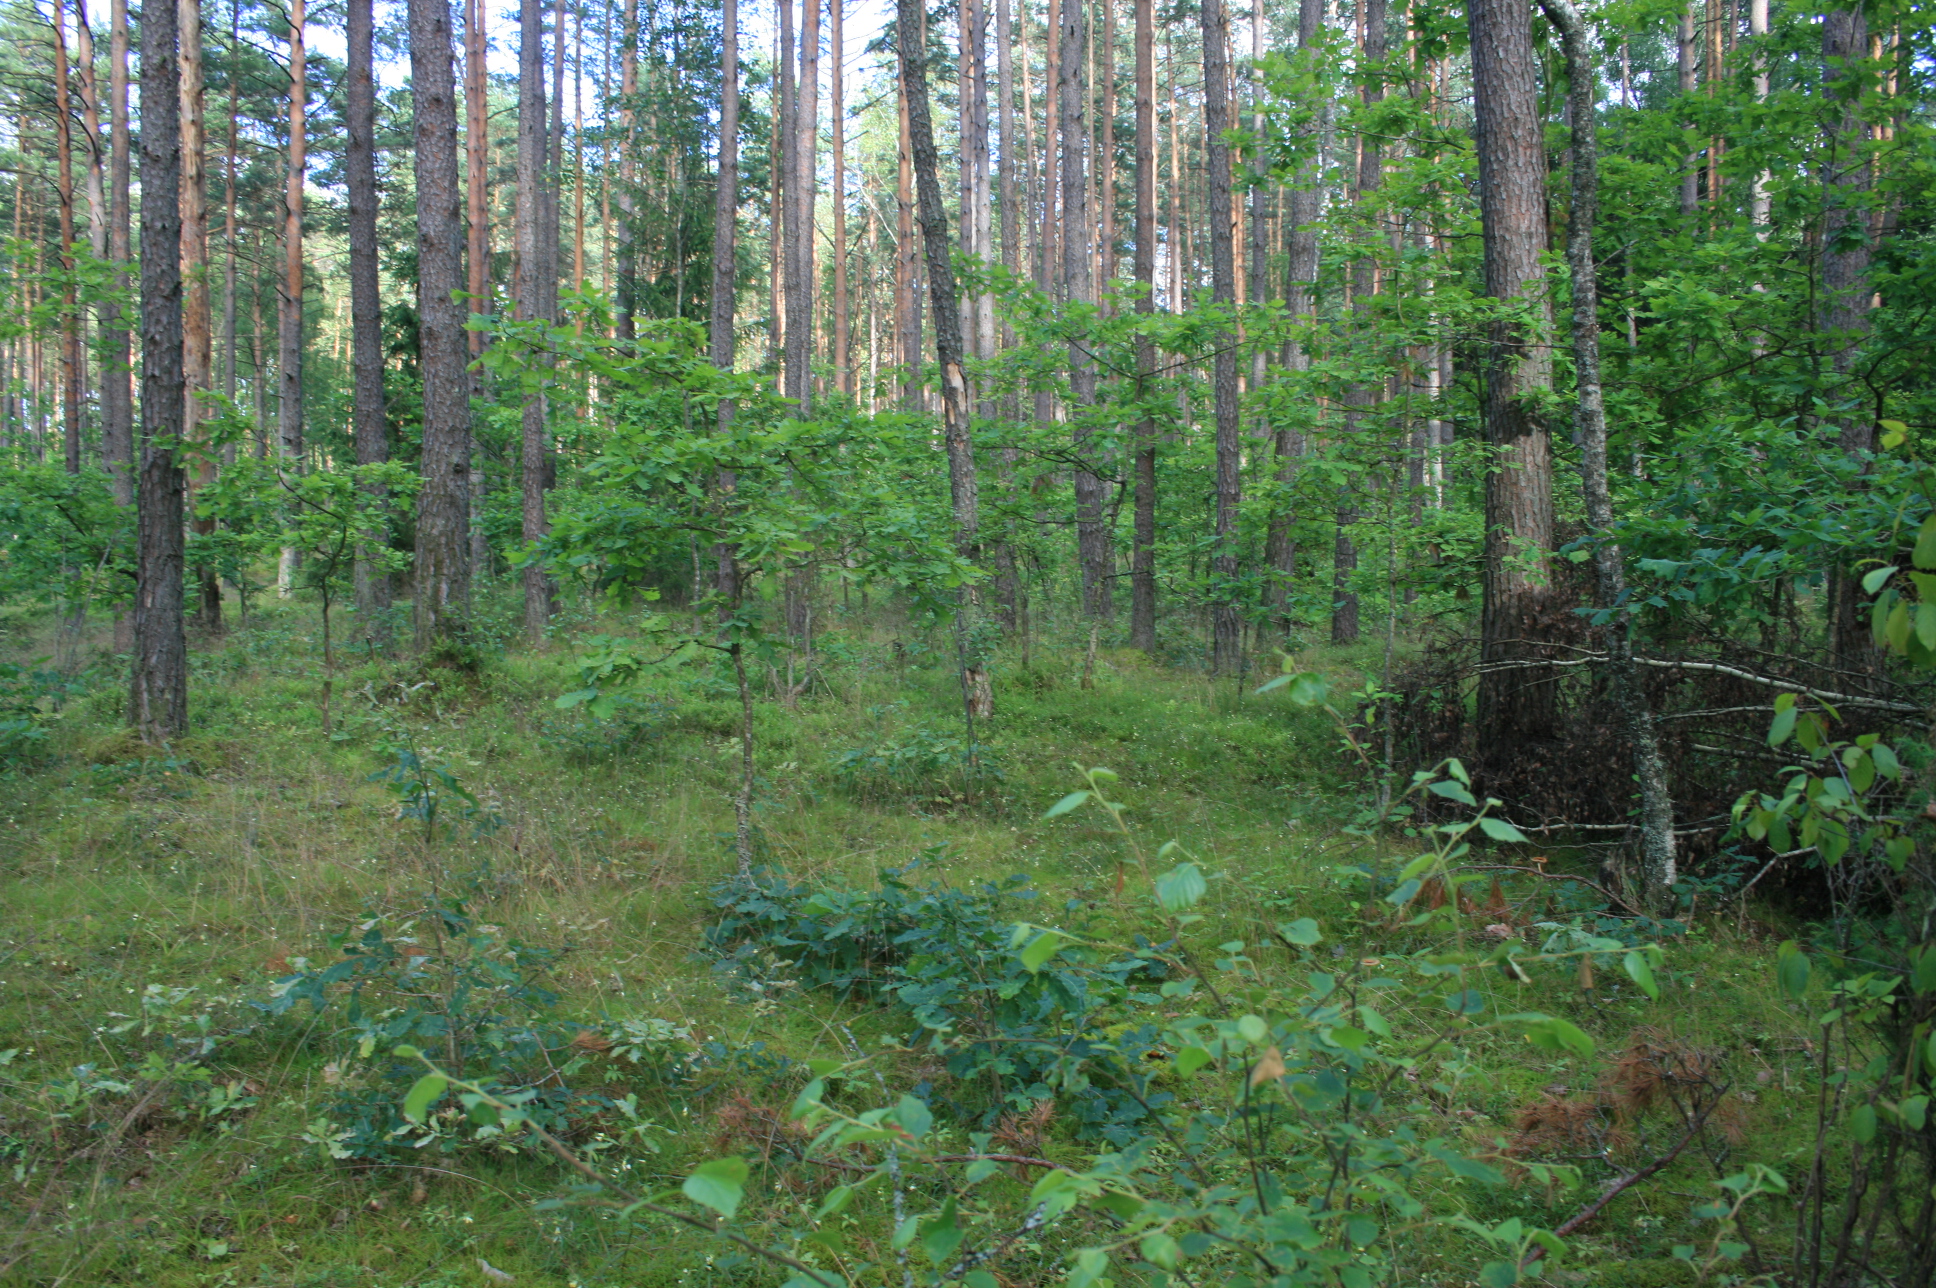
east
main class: Woodland
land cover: Pine dominated mixed woodland
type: hemiboreal forest and nemoral coniferous forest and mixed broadleaved-coniferous forest
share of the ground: 50 - 75 %
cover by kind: coniferous forest trees 40 %, lichens and mosses 25 %, broadleaved forest trees 20 %, herbaceous plants 10 %, shrubs 5 %
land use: Forestry
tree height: > 5 m
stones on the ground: < 10 %
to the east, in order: Pine dominated mixed woodland; Pine dominated coniferous woodland; Pine dominated mixed woodland; Tracks; Pine dominated mixed woodland
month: July
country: LT
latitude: 55.4824
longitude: 21.5503
